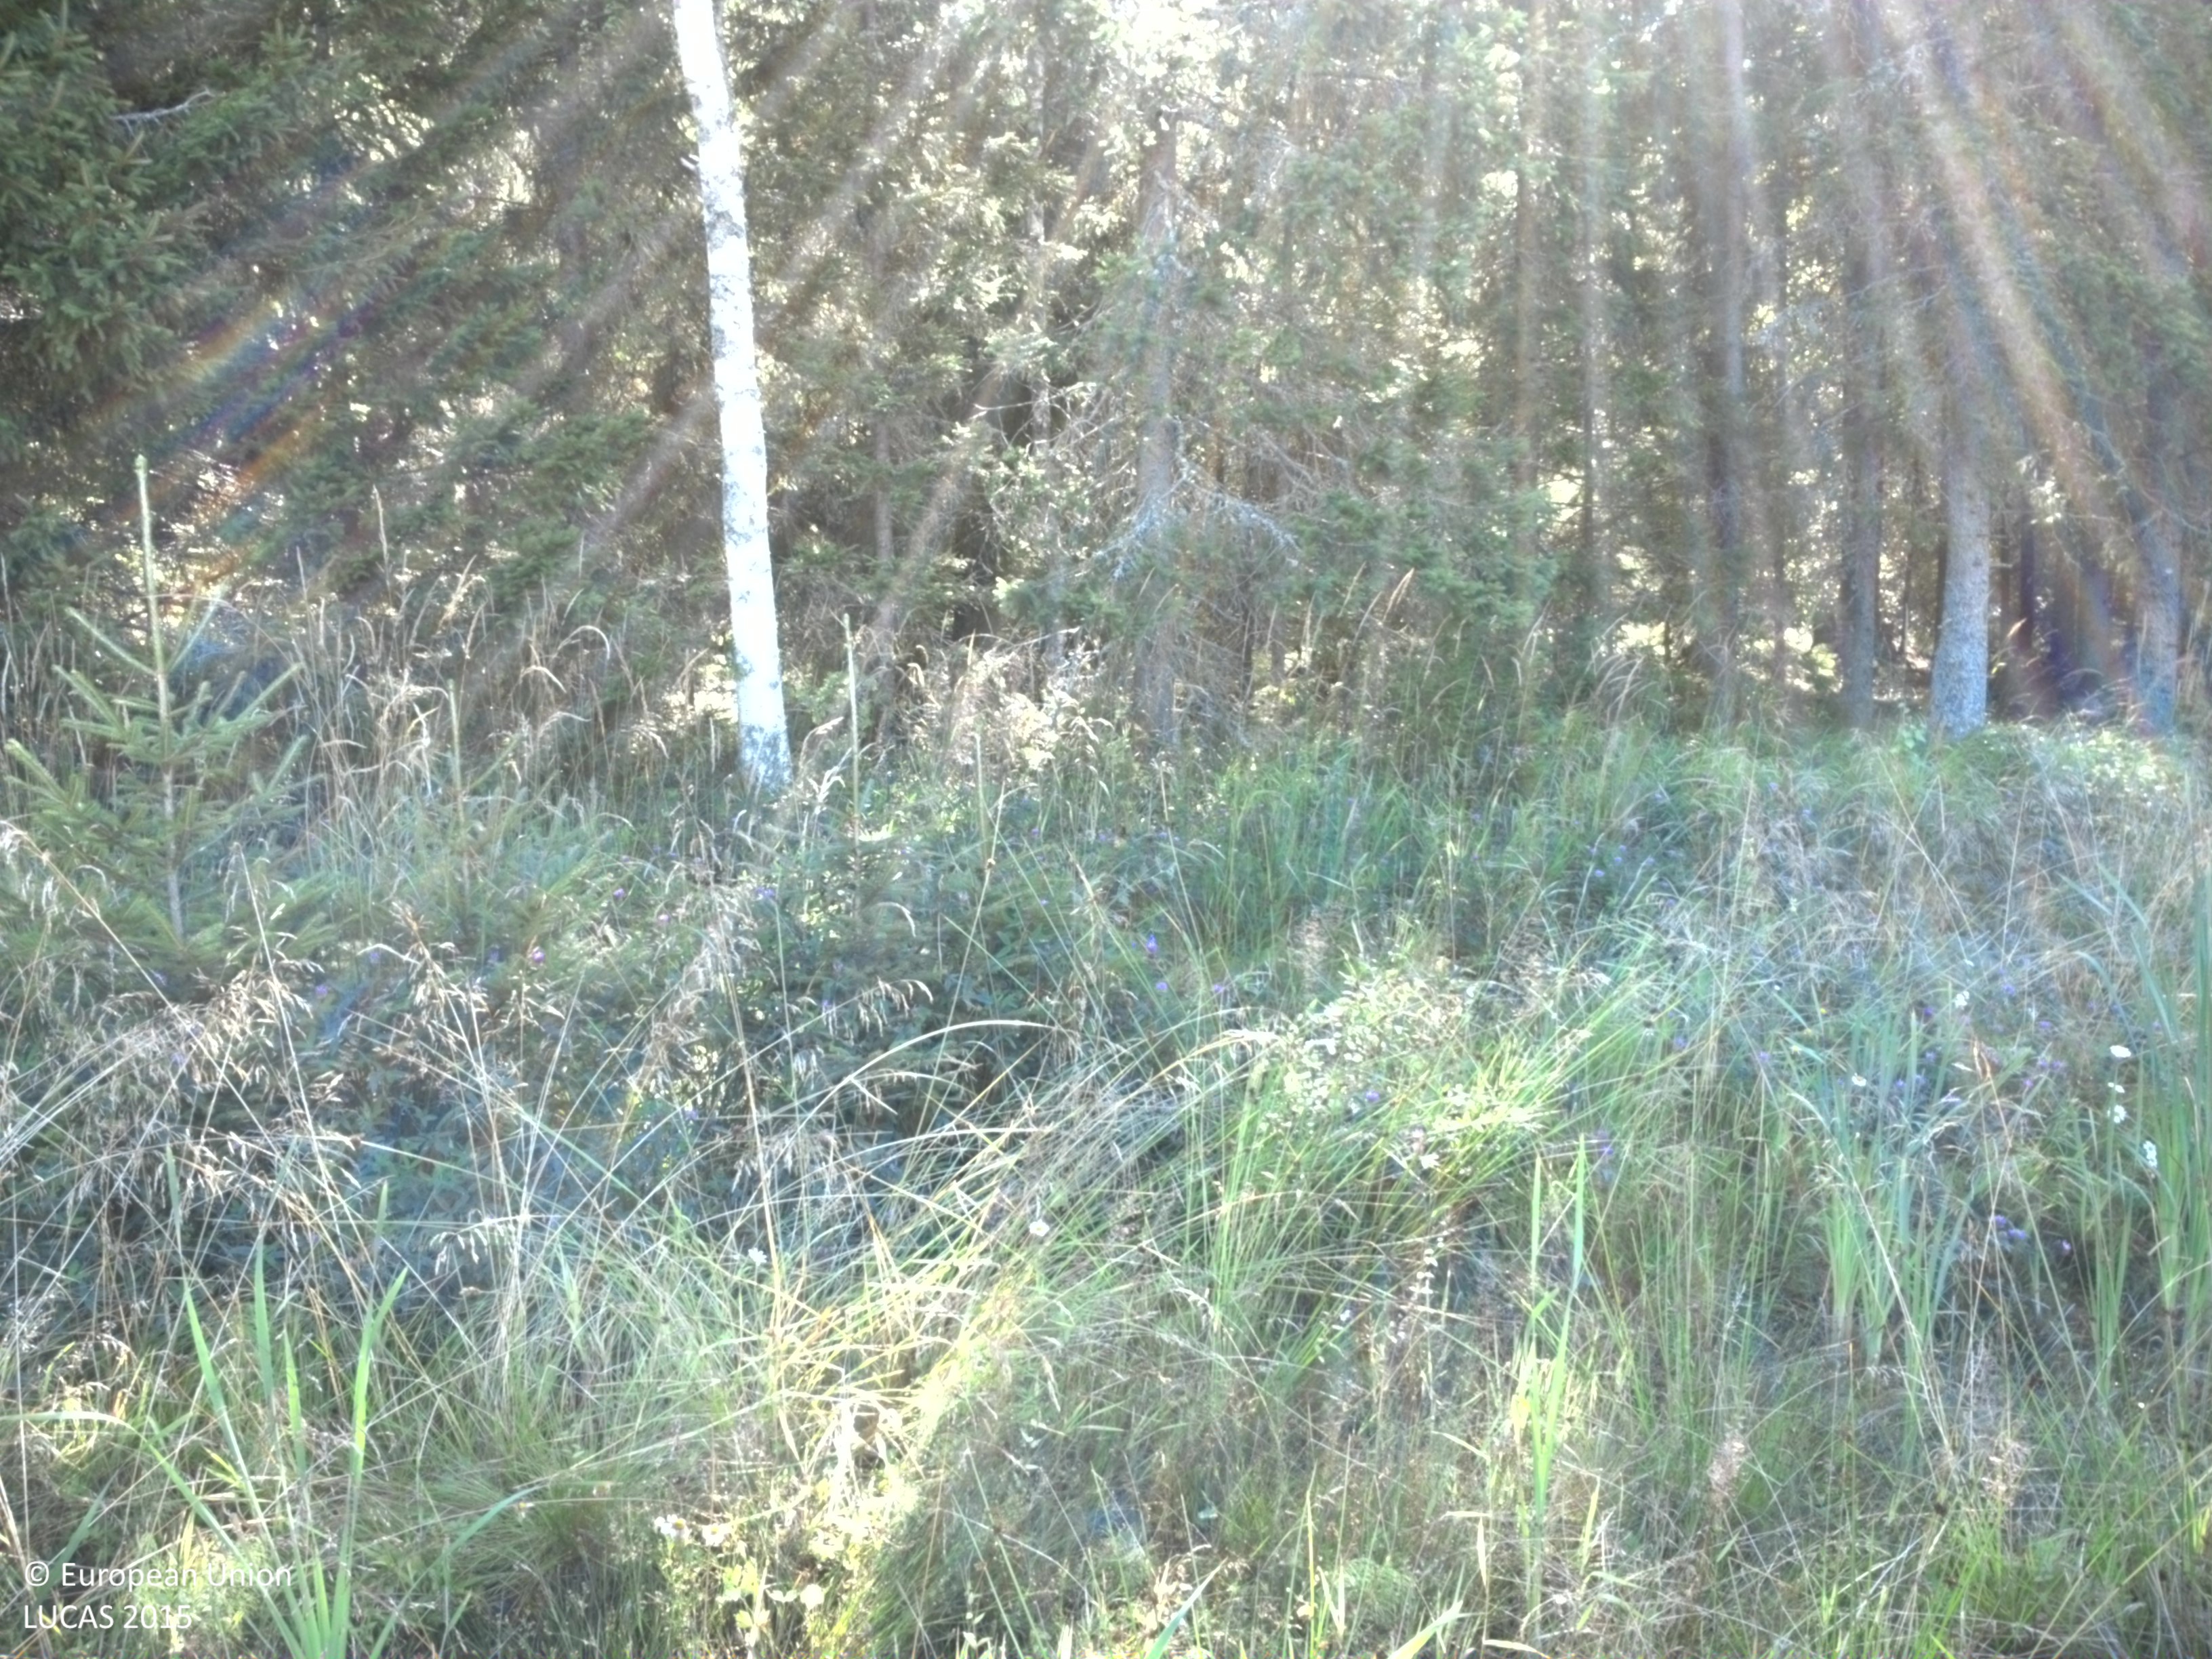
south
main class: Grassland
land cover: Grassland without tree/shrub cover
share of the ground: > 75 %
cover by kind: herbaceous plants 100 %
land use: Agriculture (excluding fallow land and kitchen gardens)
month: August
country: SE
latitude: 60.1158
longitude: 16.9905
